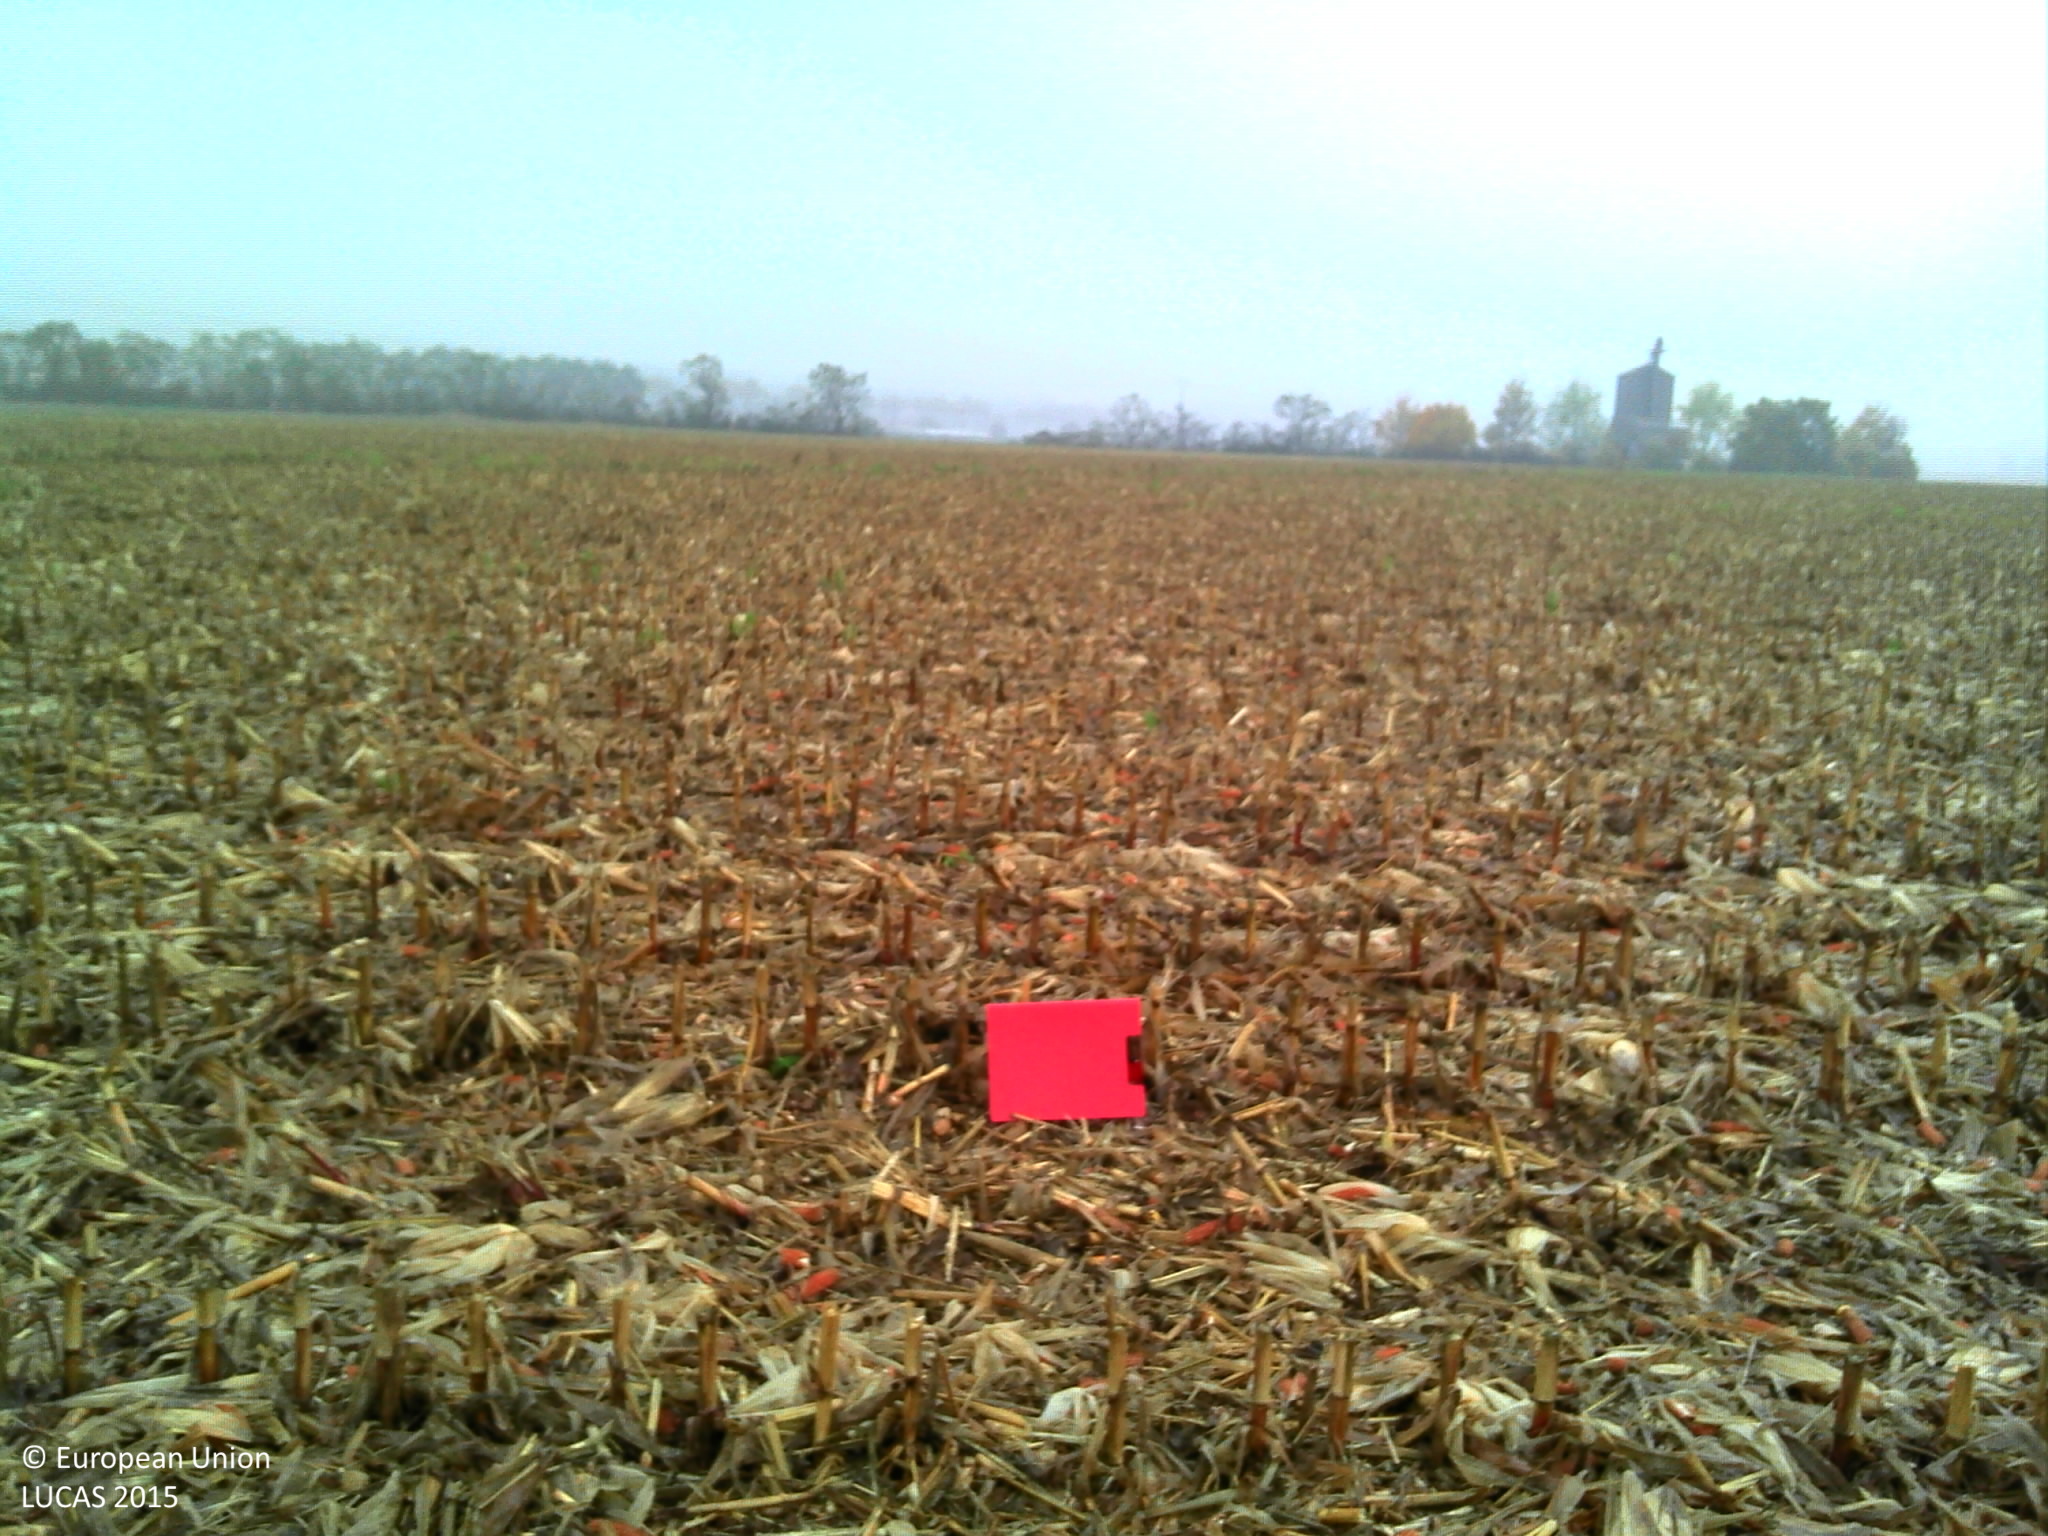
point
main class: Cropland
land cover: Maize
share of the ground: 10 - 25 %
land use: Agriculture (excluding fallow land and kitchen gardens)
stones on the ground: 10 - 25 %
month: December
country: FR
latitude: 45.8813
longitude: 5.1718
